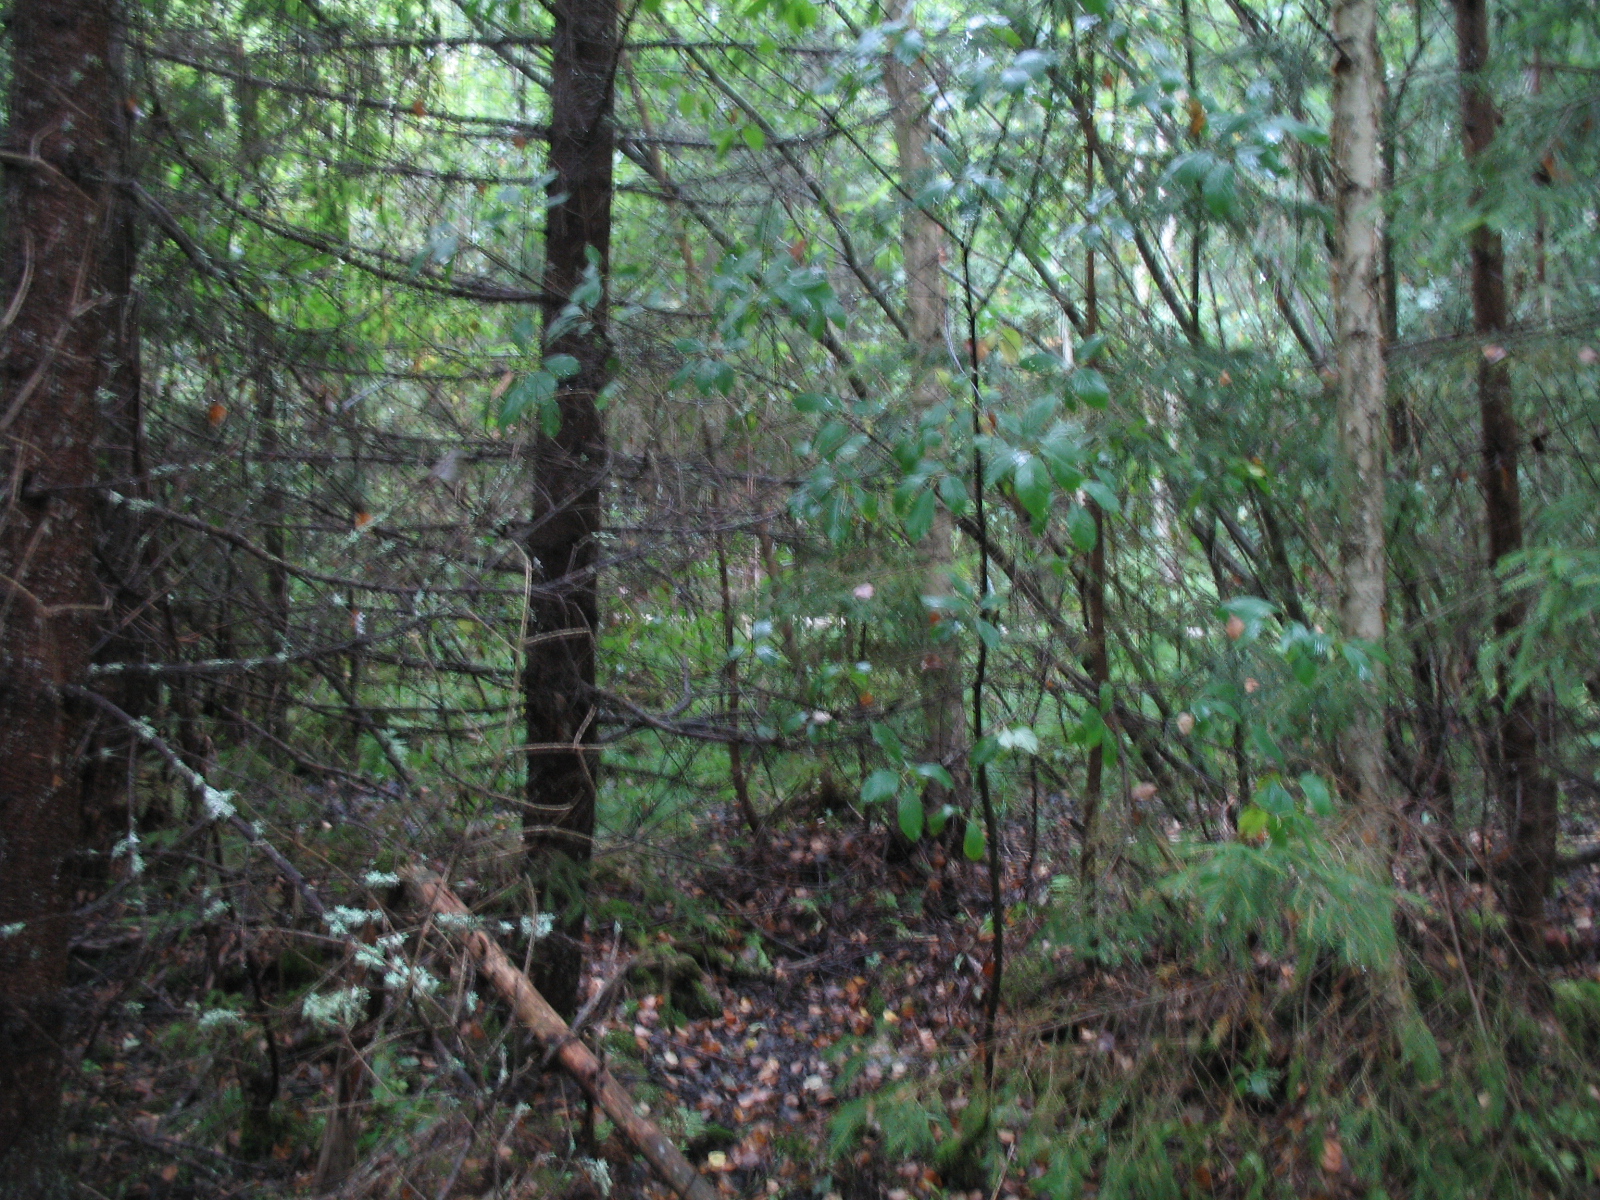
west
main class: Woodland
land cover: Spruce dominated mixed woodland
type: hemiboreal forest and nemoral coniferous forest and mixed broadleaved-coniferous forest
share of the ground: > 75 %
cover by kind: coniferous forest trees 45 %, broadleaved forest trees 40 %, herbaceous plants 10 %, lichens and mosses 5 %
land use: Forestry
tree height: > 5 m
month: September
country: LV
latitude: 56.1171
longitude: 26.2417
